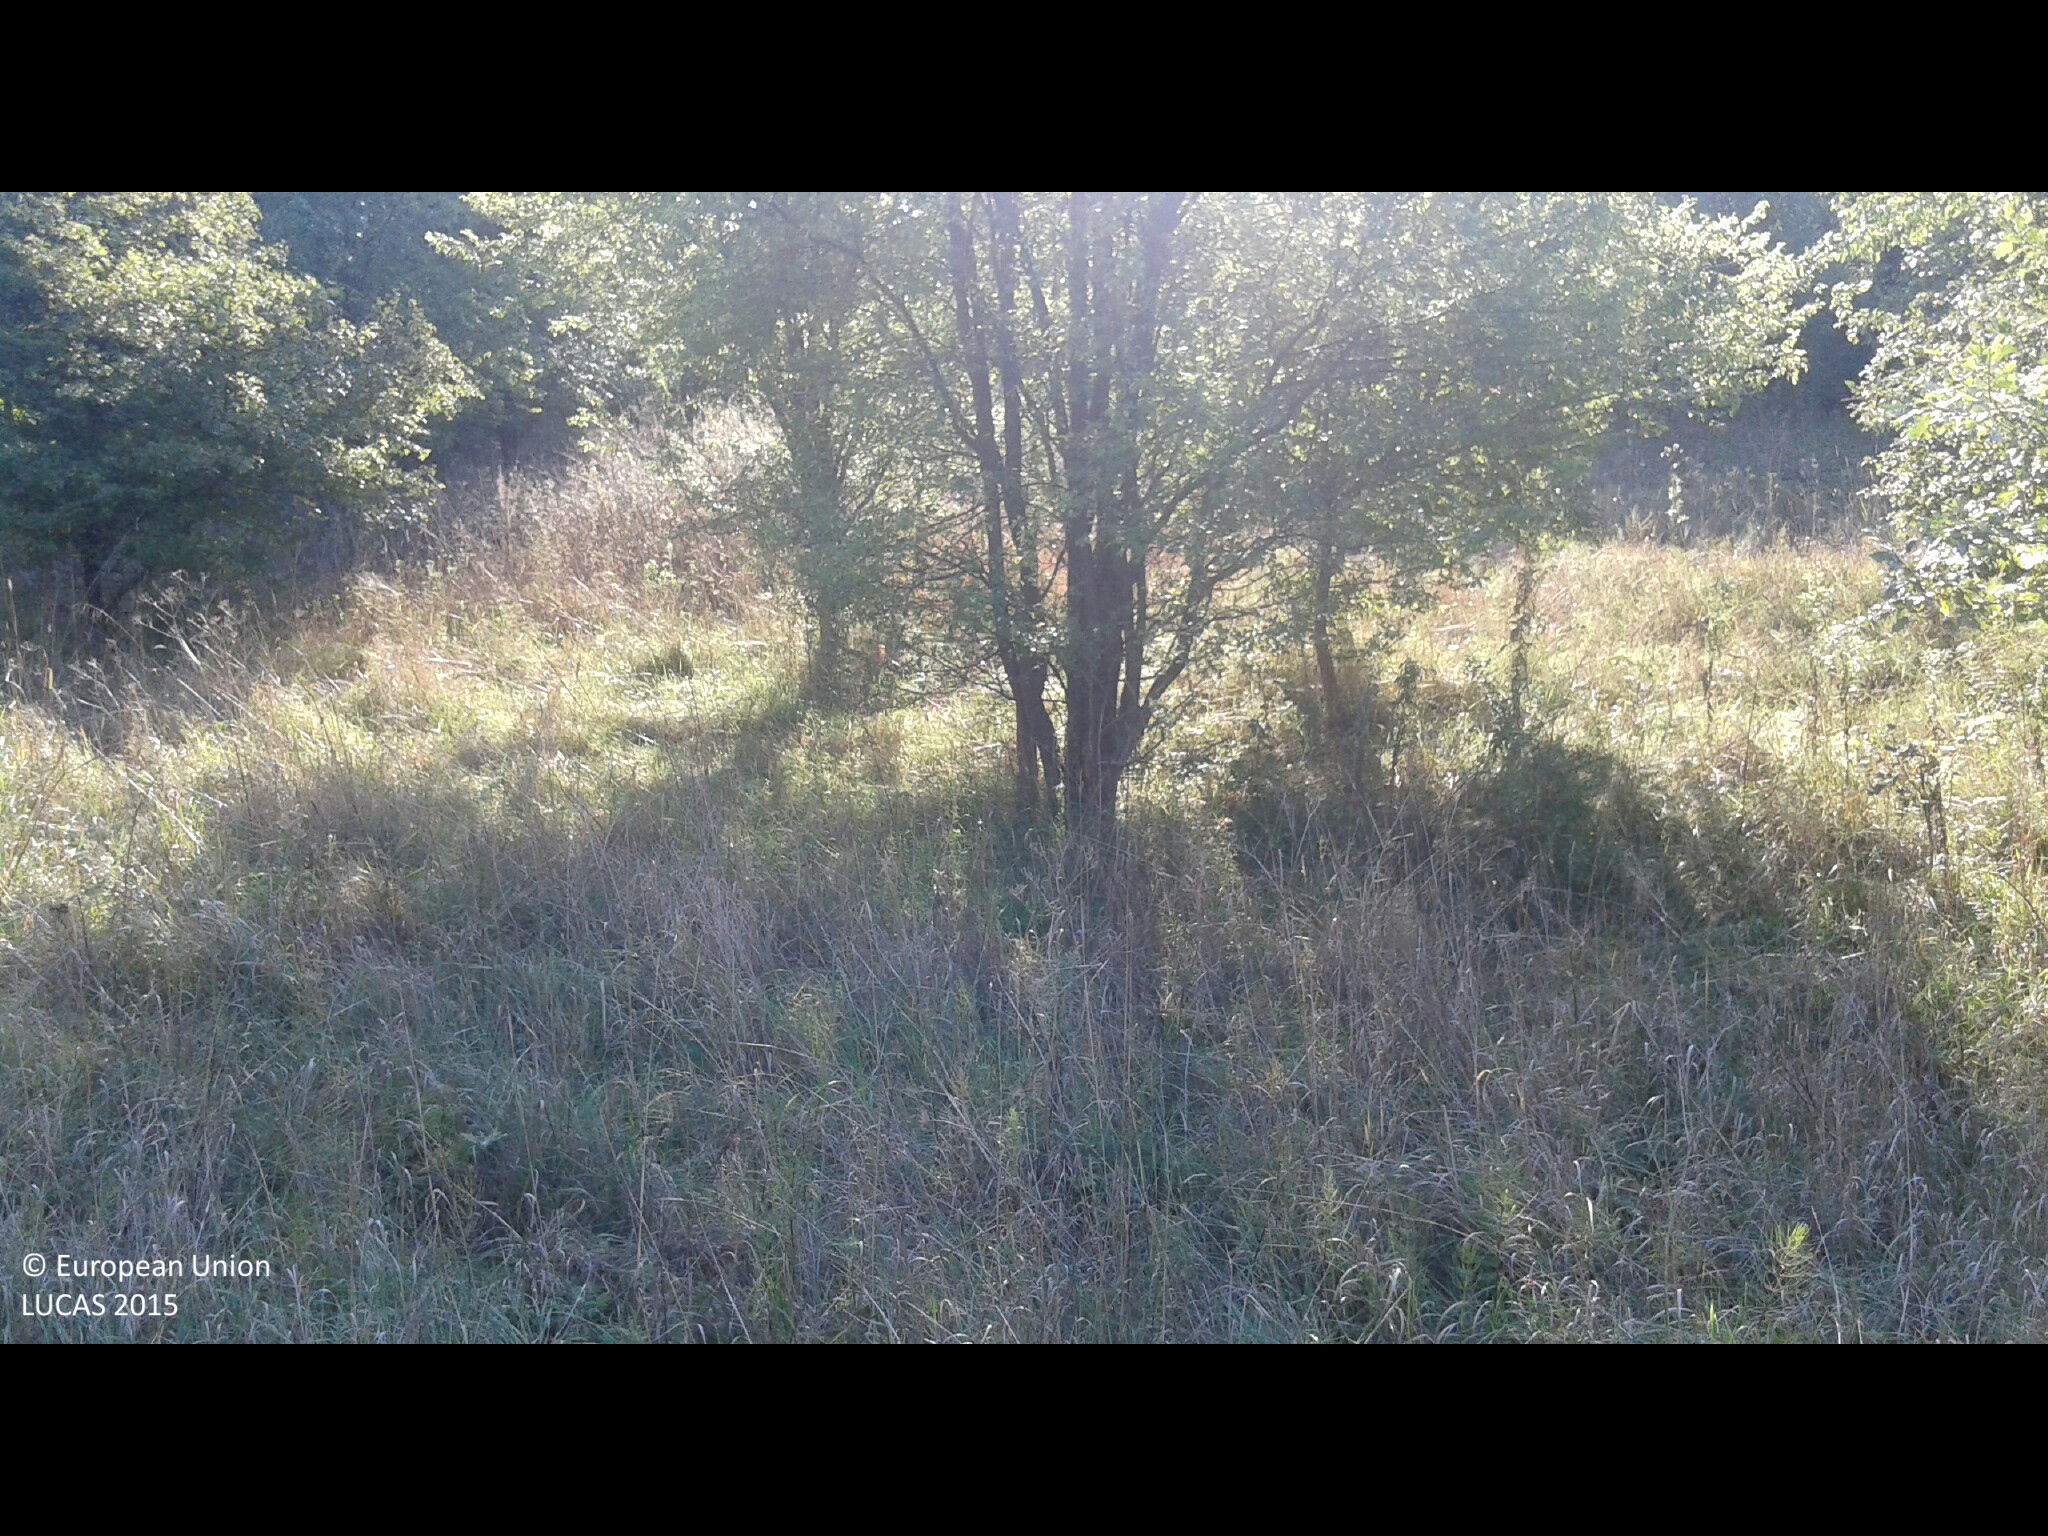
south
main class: Cropland
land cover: Cherry fruit
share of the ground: 25 - 50 %
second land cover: Grassland without tree/shrub cover
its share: > 75 %
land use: Agriculture (excluding fallow land and kitchen gardens)
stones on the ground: < 10 %
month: September
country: PL
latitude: 53.8554
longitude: 20.2350
